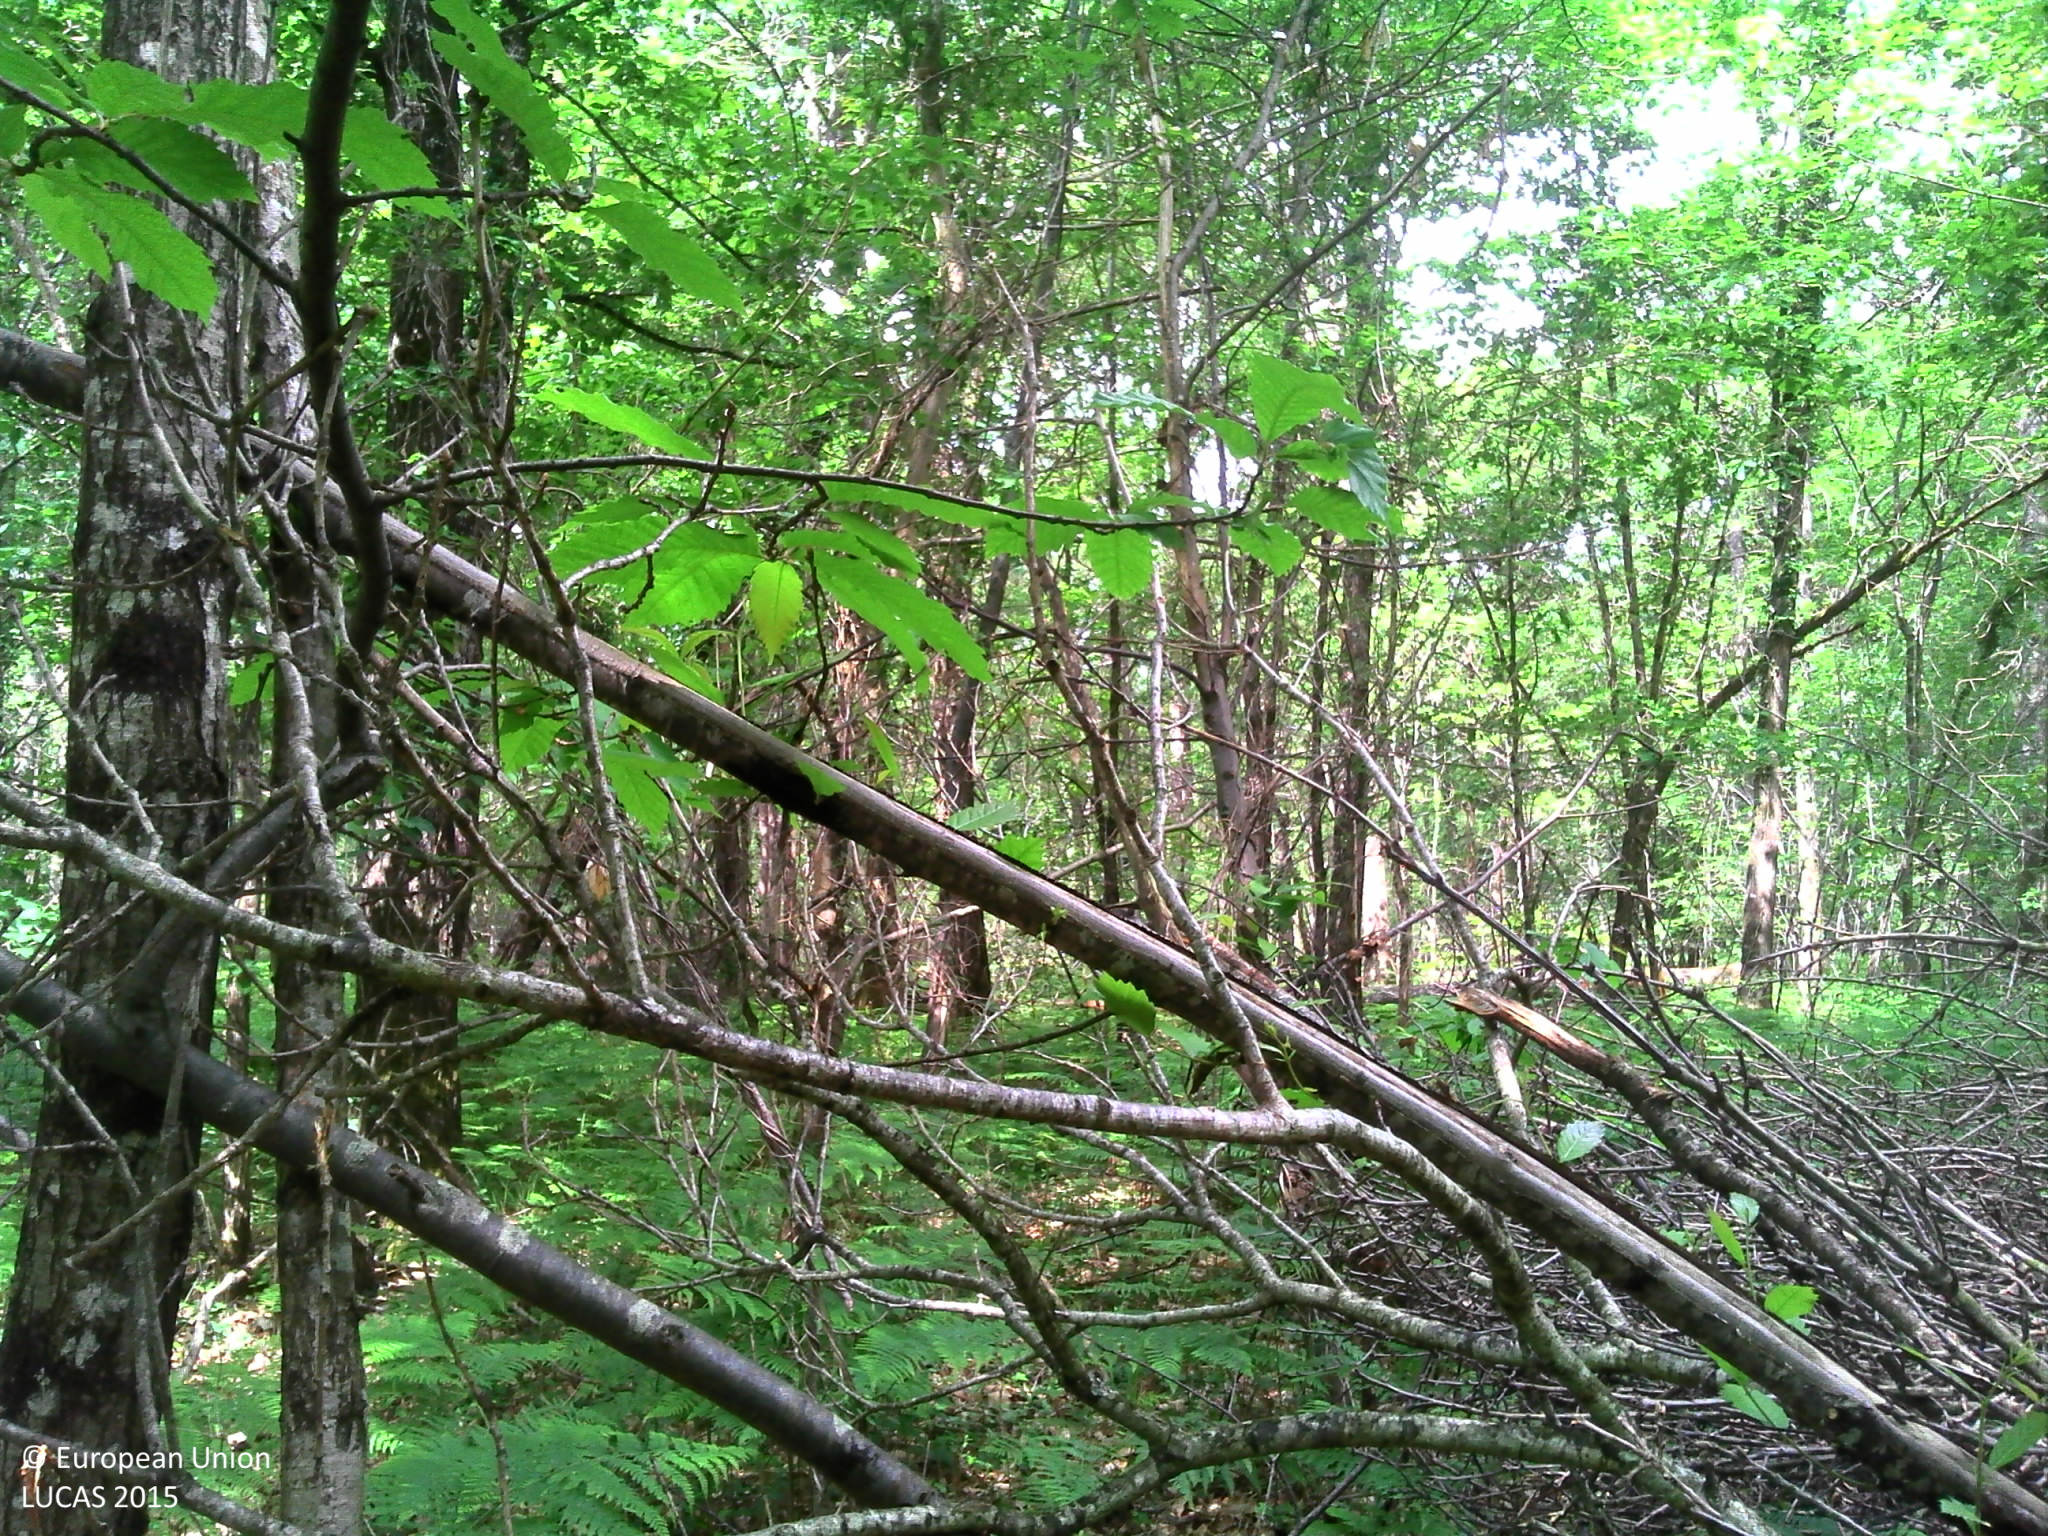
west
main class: Woodland
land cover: Broadleaved woodland
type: mesophytic deciduous forest
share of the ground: > 75 %
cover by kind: broadleaved forest trees 75 %, herbaceous plants 20 %, lichens and mosses 5 %
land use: Forestry
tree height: > 5 m
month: May
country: FR
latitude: 47.6888
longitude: 0.7471
